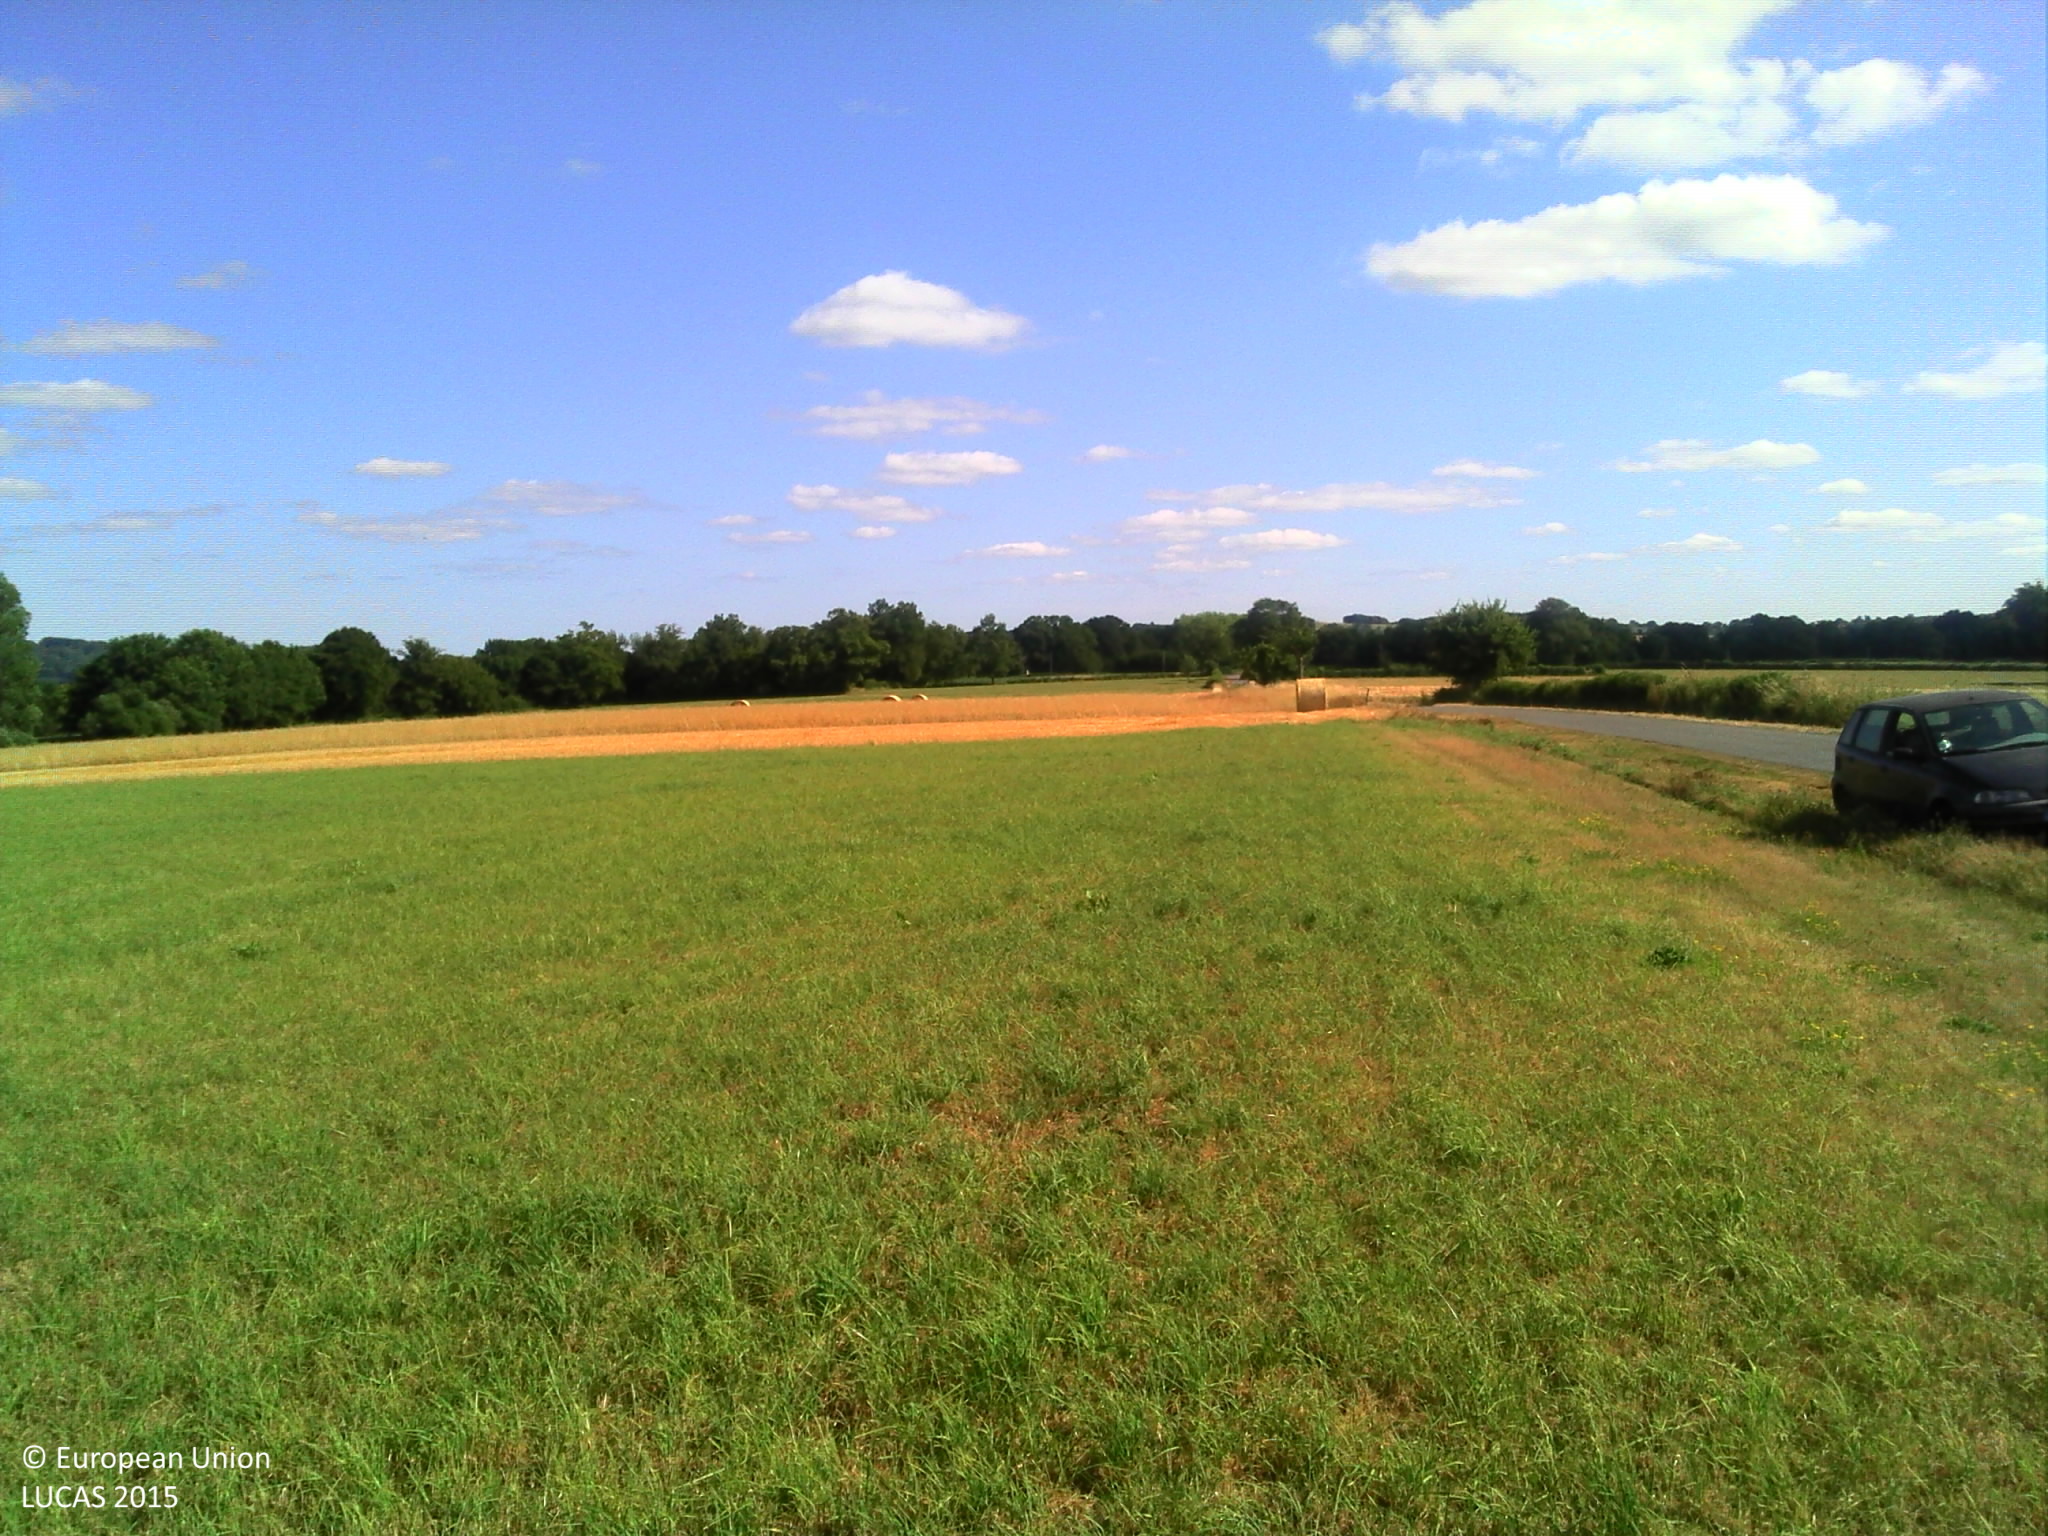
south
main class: Grassland
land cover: Grassland without tree/shrub cover
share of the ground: > 75 %
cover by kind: herbaceous plants 100 %
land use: Agriculture (excluding fallow land and kitchen gardens)
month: July
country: FR
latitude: 46.3113
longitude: 1.6155
